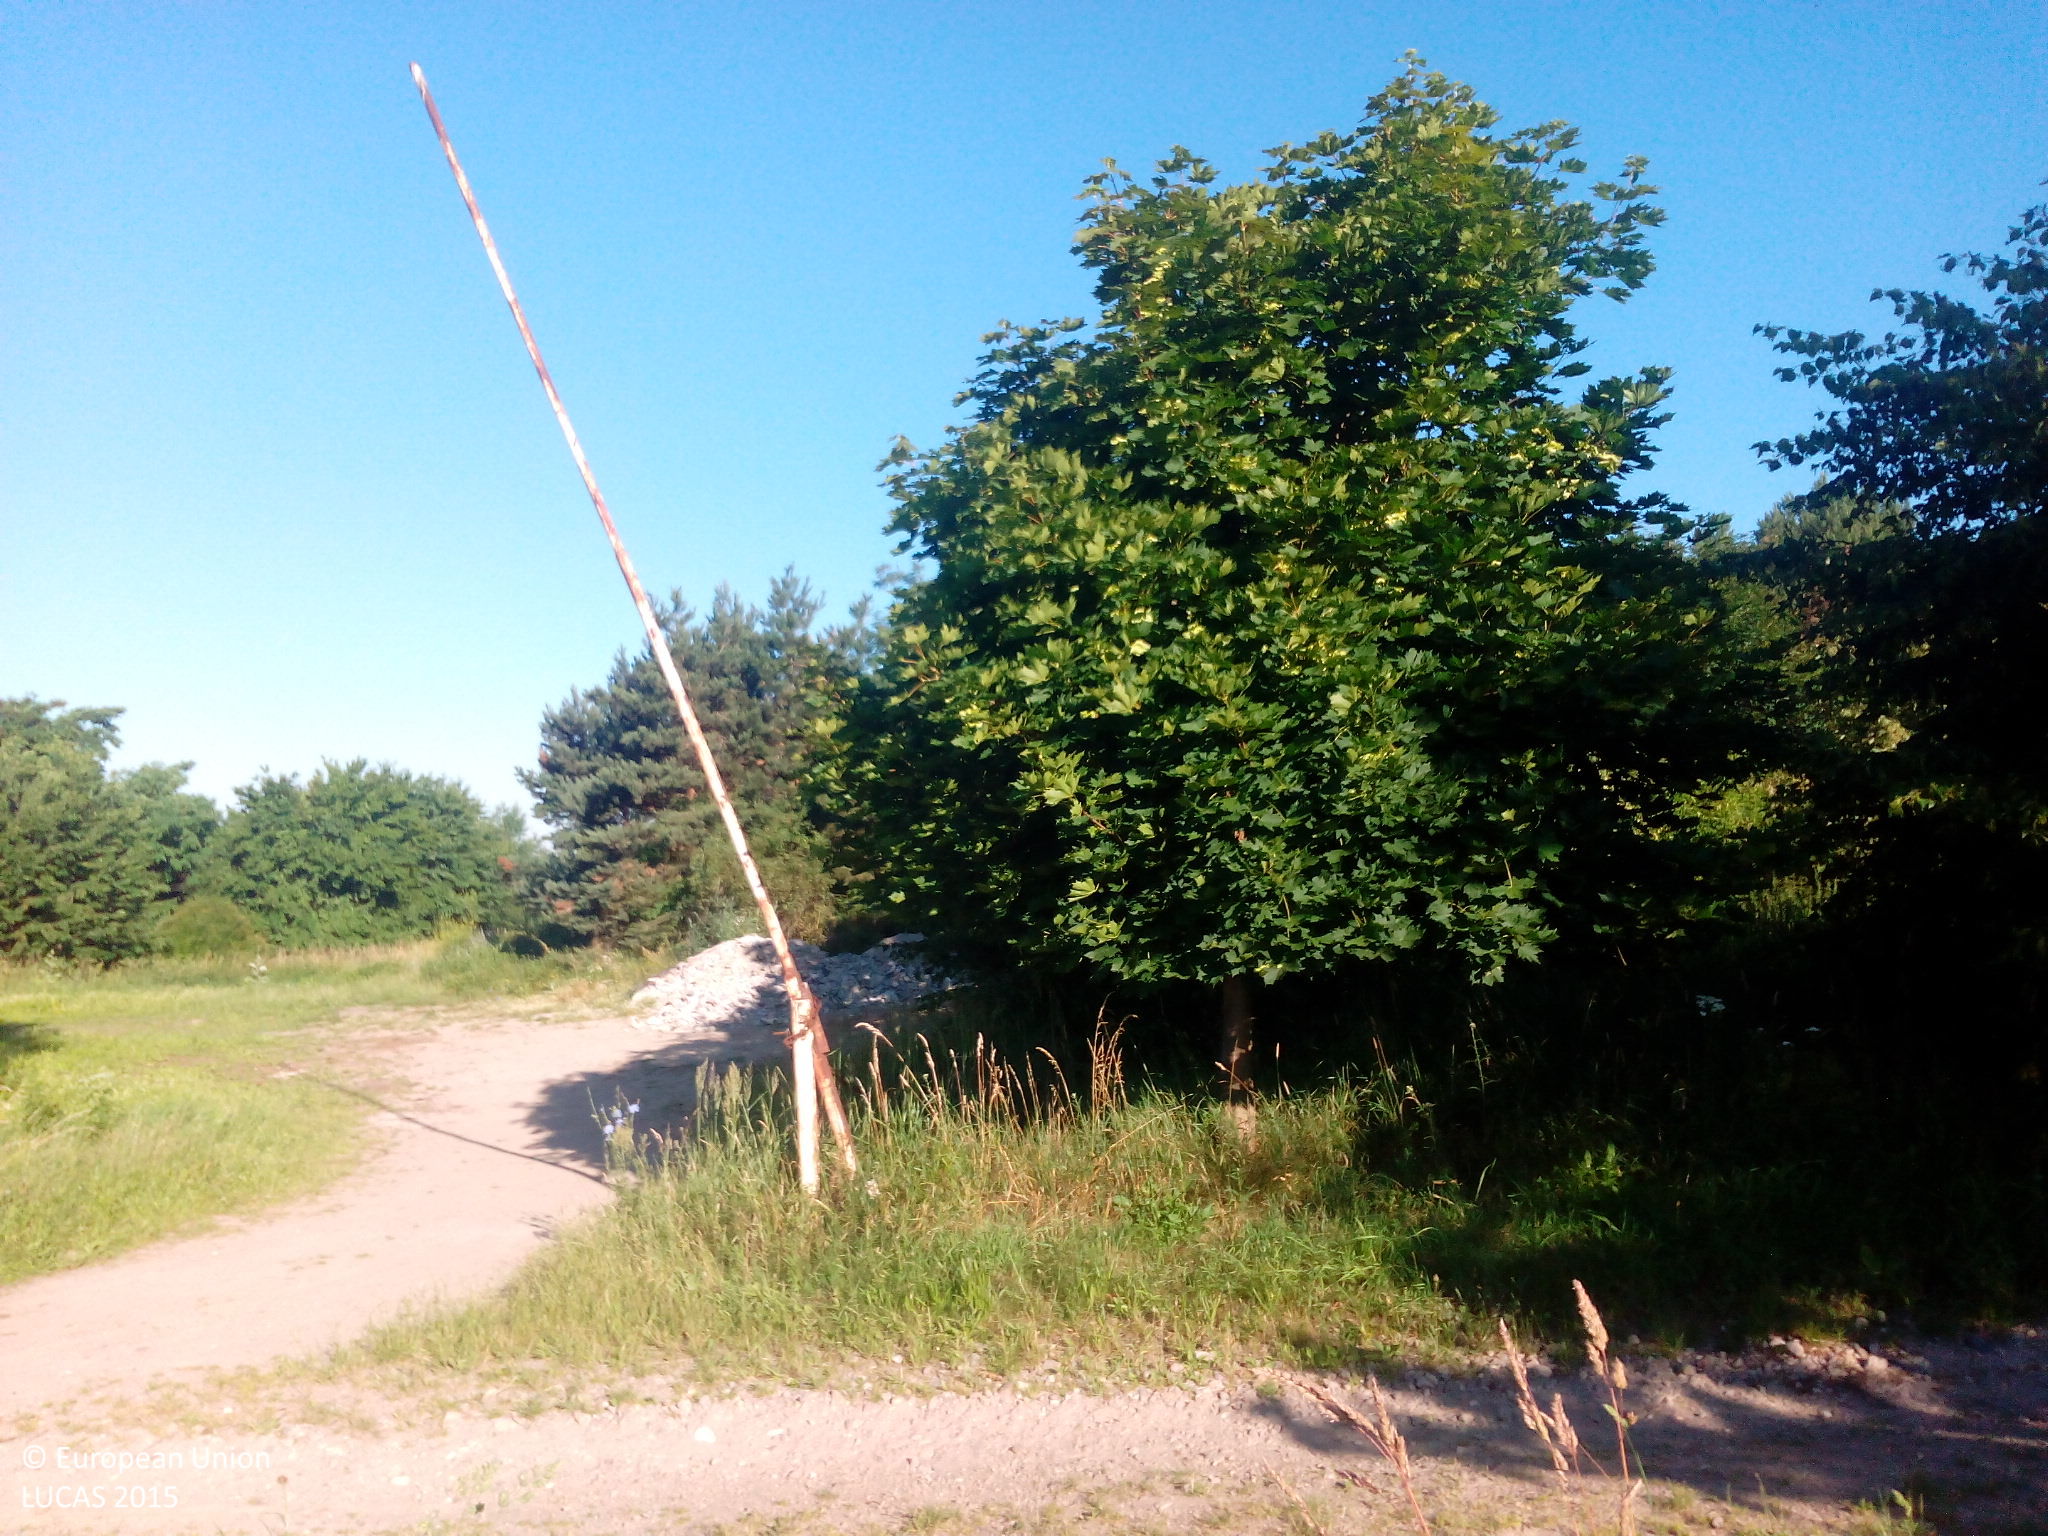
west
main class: Cropland
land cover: Rape and turnip rape
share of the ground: > 75 %
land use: Agriculture (excluding fallow land and kitchen gardens)
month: July
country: DE
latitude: 51.3652
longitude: 13.1169
